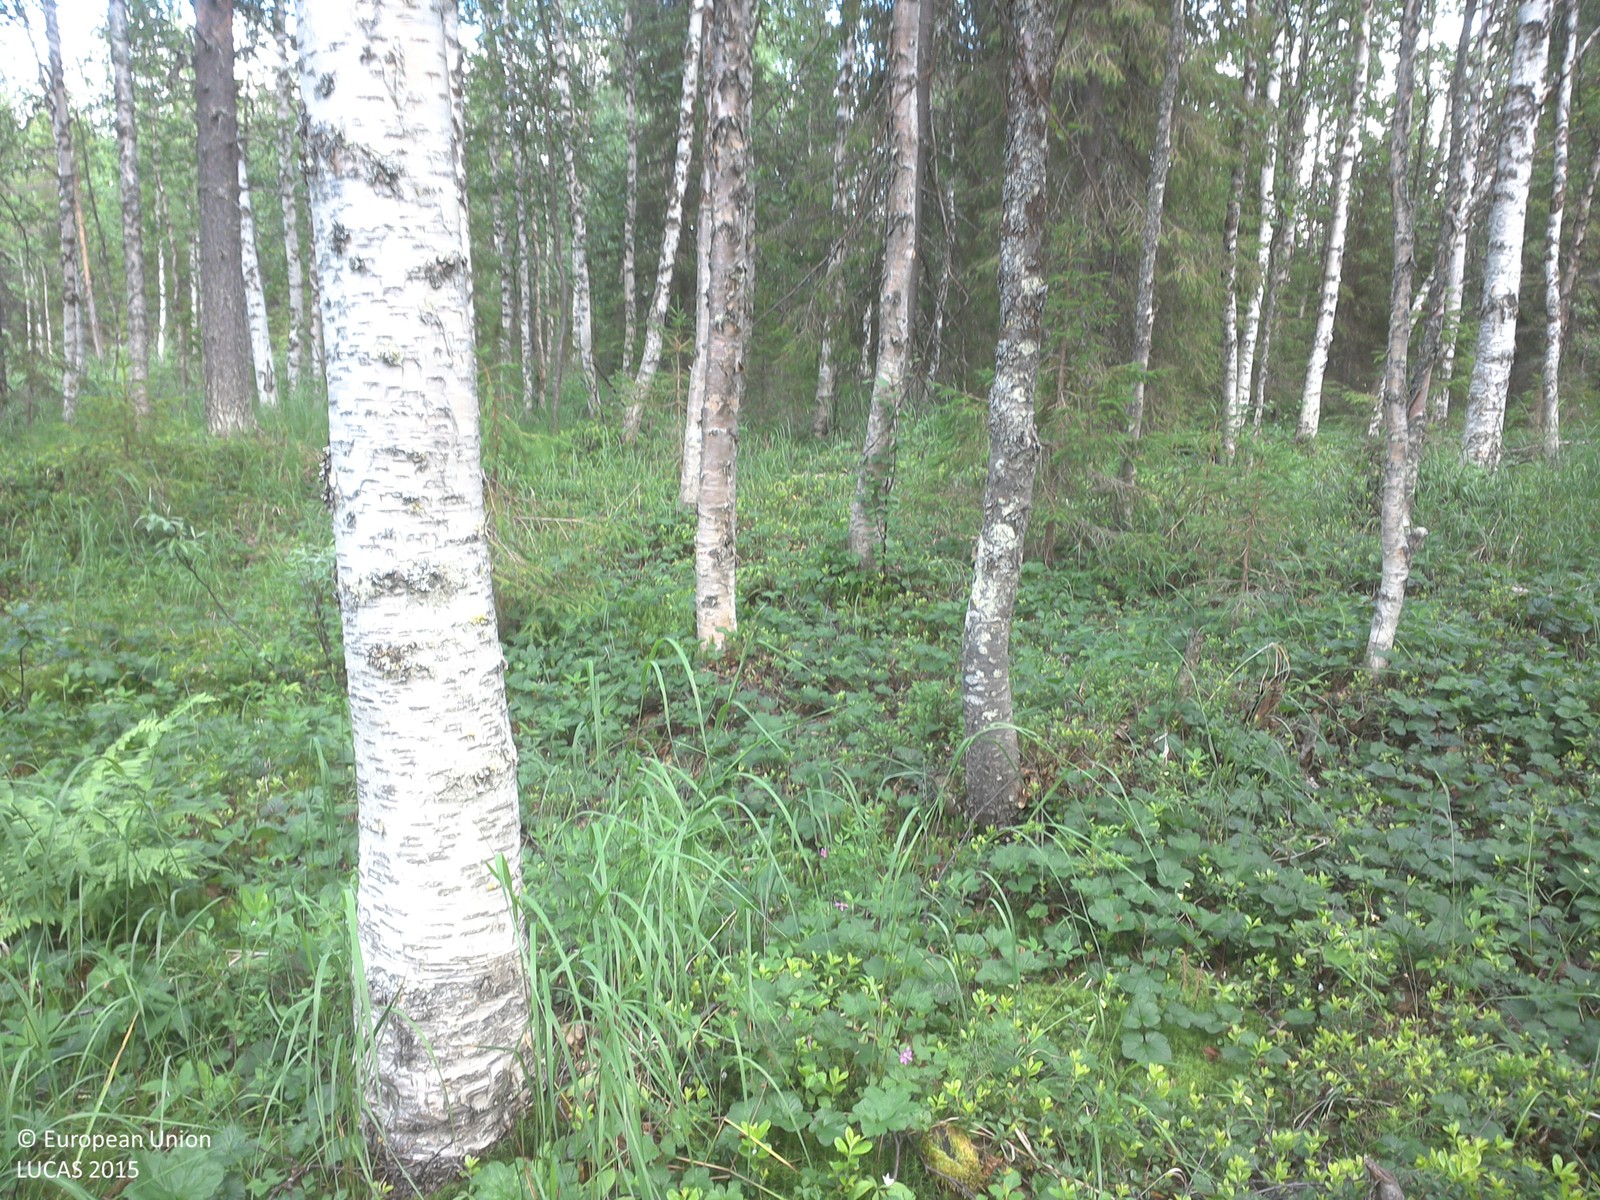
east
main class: Woodland
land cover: Other mixed woodland
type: boreal forest
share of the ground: 25 - 50 %
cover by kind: broadleaved forest trees 30 %, herbaceous plants 30 %, shrubs 15 %, lichens and mosses 15 %, coniferous forest trees 10 %
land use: Forestry
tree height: > 5 m
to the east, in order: Other mixed woodland; Spruce dominated mixed woodland; Ditches and canals; Spruce dominated mixed woodland; Peatbogs
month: July
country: SE
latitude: 67.6510
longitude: 23.4699
